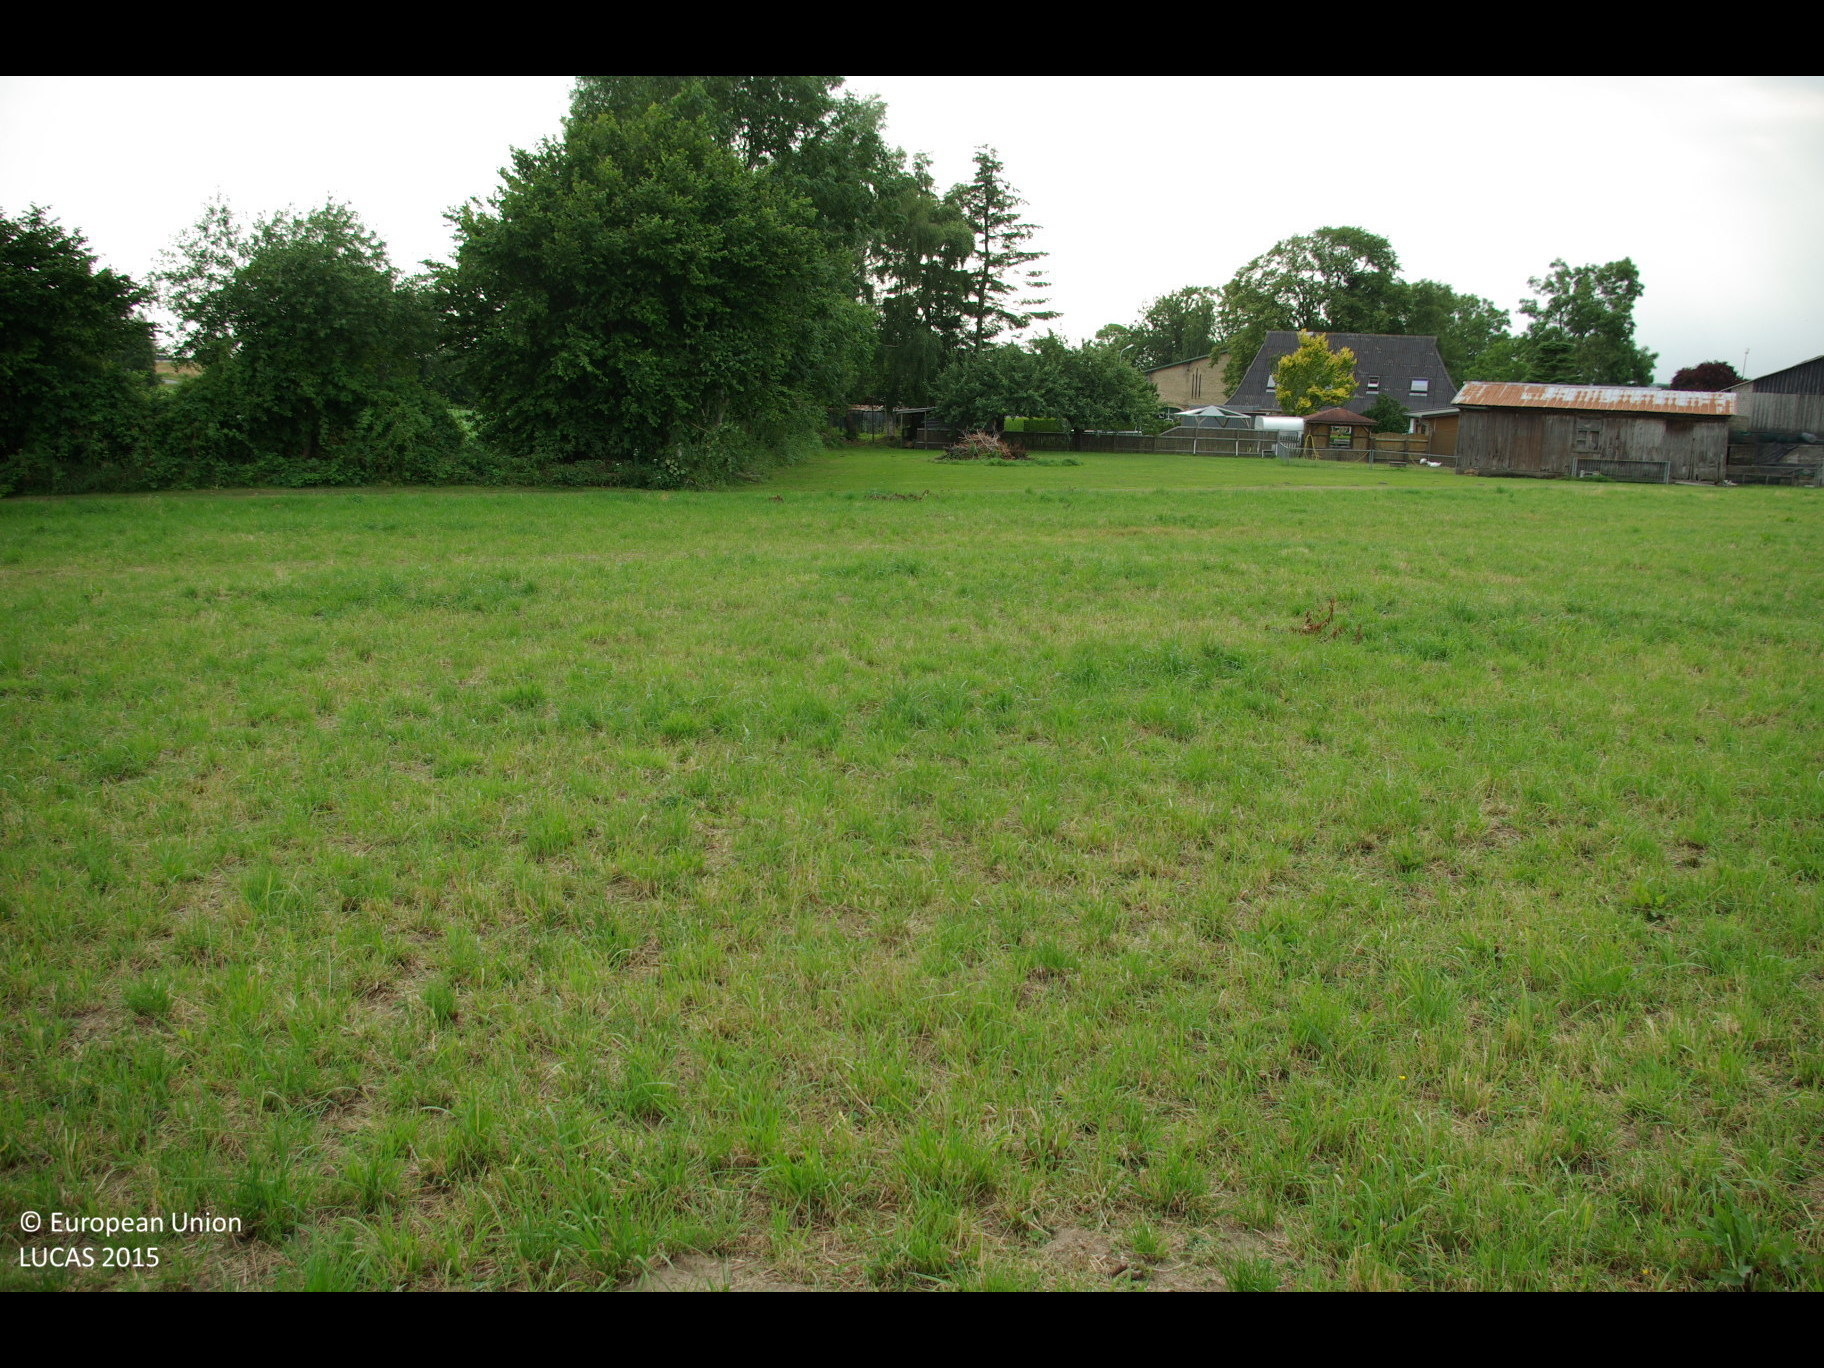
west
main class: Cropland
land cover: Temporary grasslands
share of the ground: > 75 %
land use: Agriculture (excluding fallow land and kitchen gardens)
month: July
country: DE
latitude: 54.6420
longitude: 9.9535
